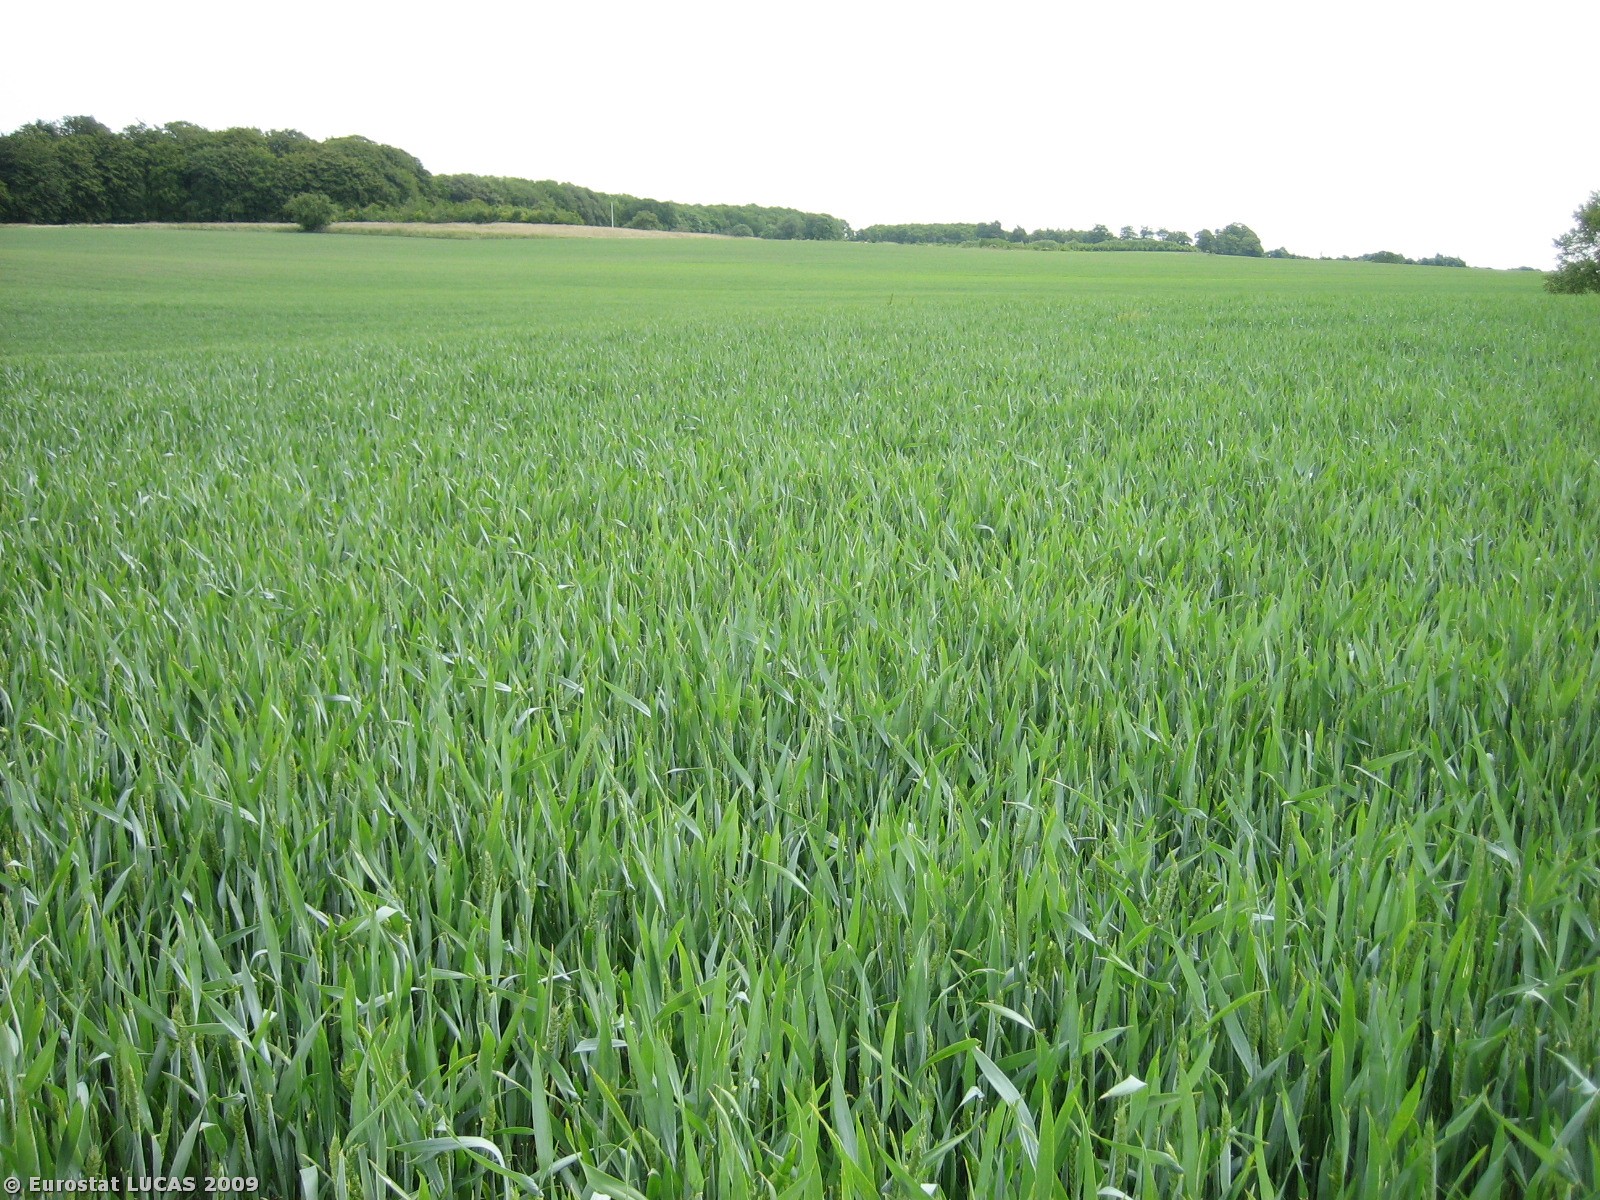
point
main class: Cropland
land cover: Common wheat
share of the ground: > 75 %
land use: Agriculture (excluding fallow land and kitchen gardens)
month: June
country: DK
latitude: 56.2596
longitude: 10.0161
